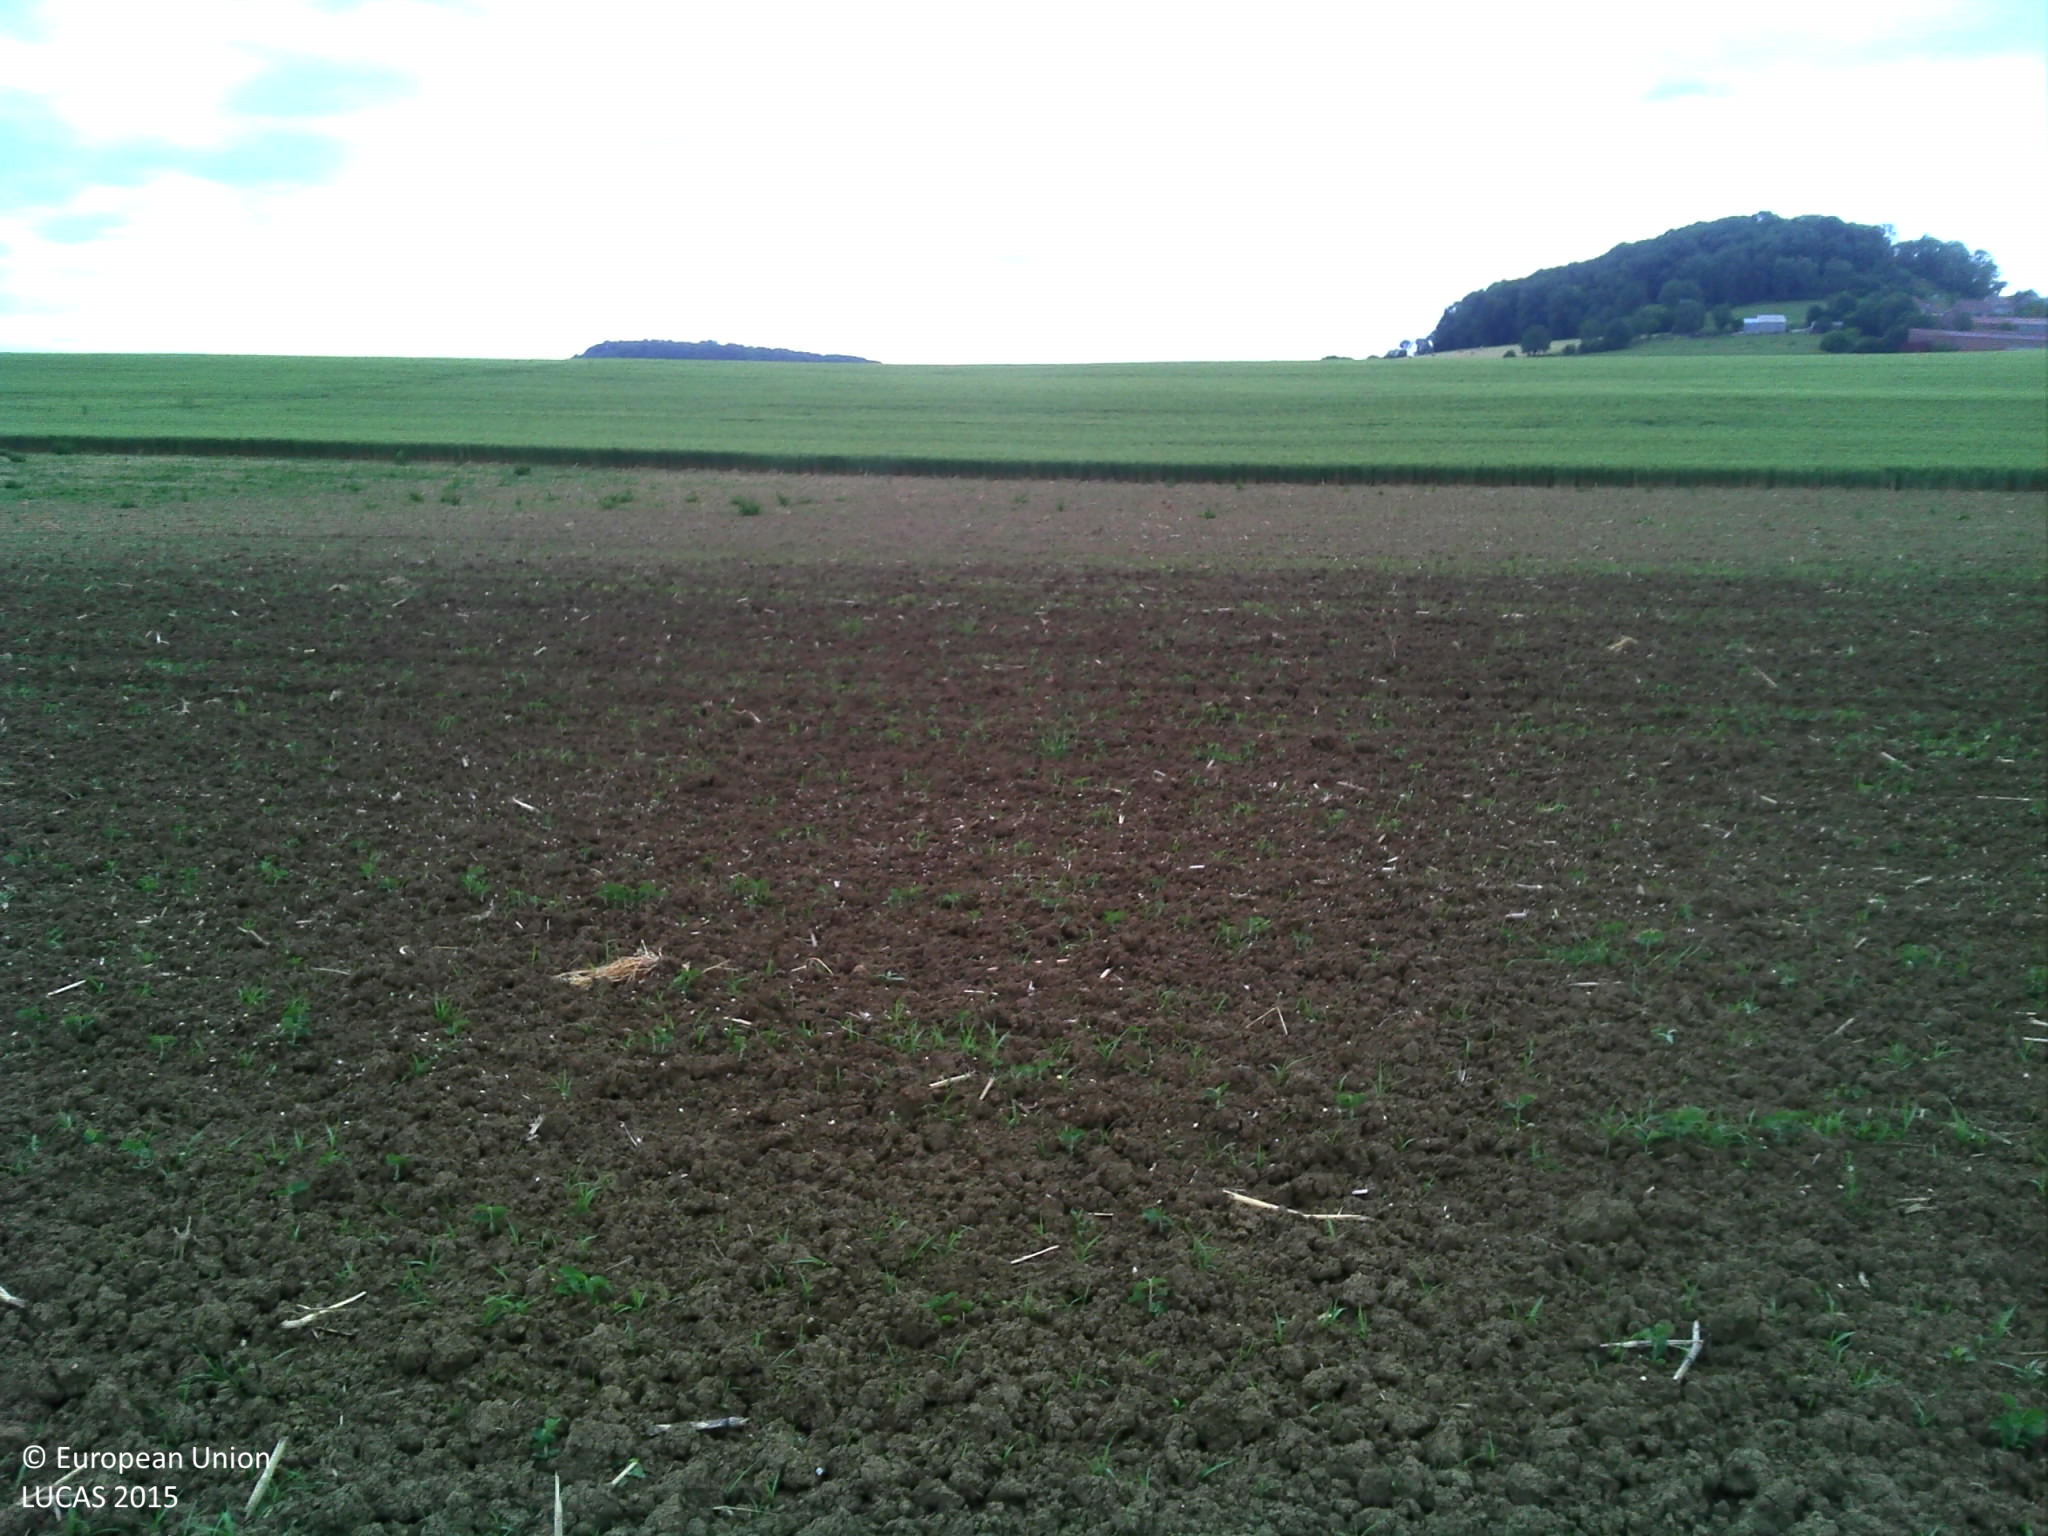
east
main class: Grassland
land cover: Grassland without tree/shrub cover
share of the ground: > 75 %
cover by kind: herbaceous plants 100 %
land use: Agriculture (excluding fallow land and kitchen gardens)
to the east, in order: Grassland without tree/shrub cover; Sunflower; Common wheat
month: June
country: FR
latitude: 47.6233
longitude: 6.3688
